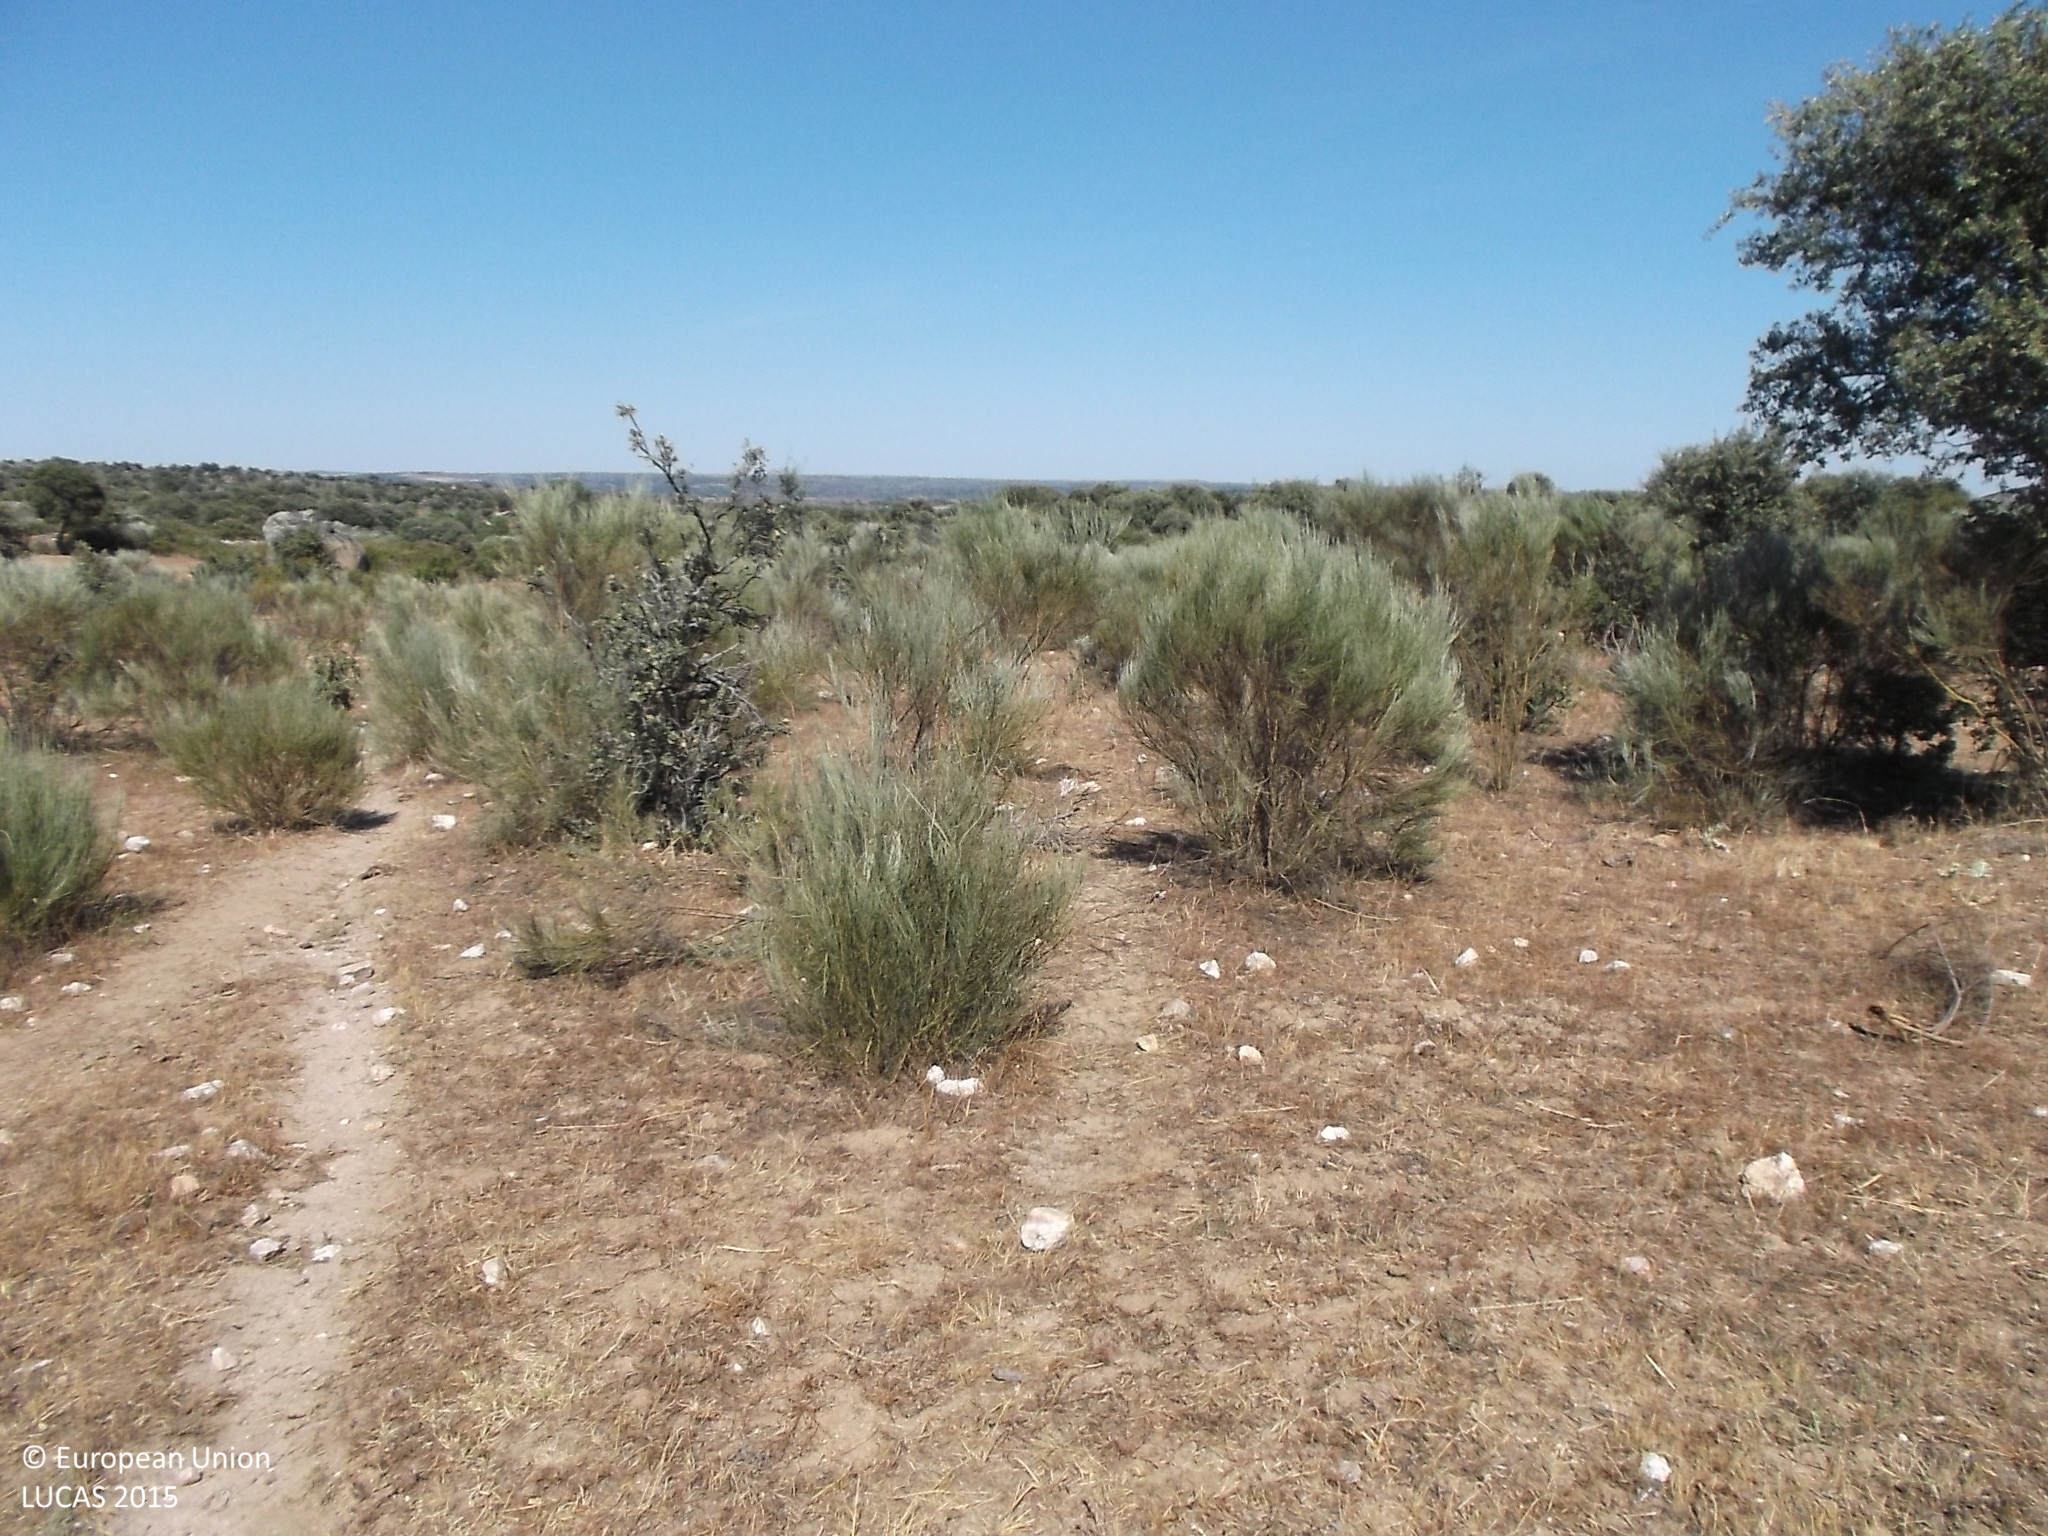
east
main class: Shrubland
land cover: Shrubland without tree cover
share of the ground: 50 - 75 %
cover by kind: shrubs 70 %, herbaceous plants 30 %
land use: Agriculture (excluding fallow land and kitchen gardens)
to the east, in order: Shrubland without tree cover; Shrubland with sparse tree cover
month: July
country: ES
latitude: 40.7972
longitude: -6.7987
